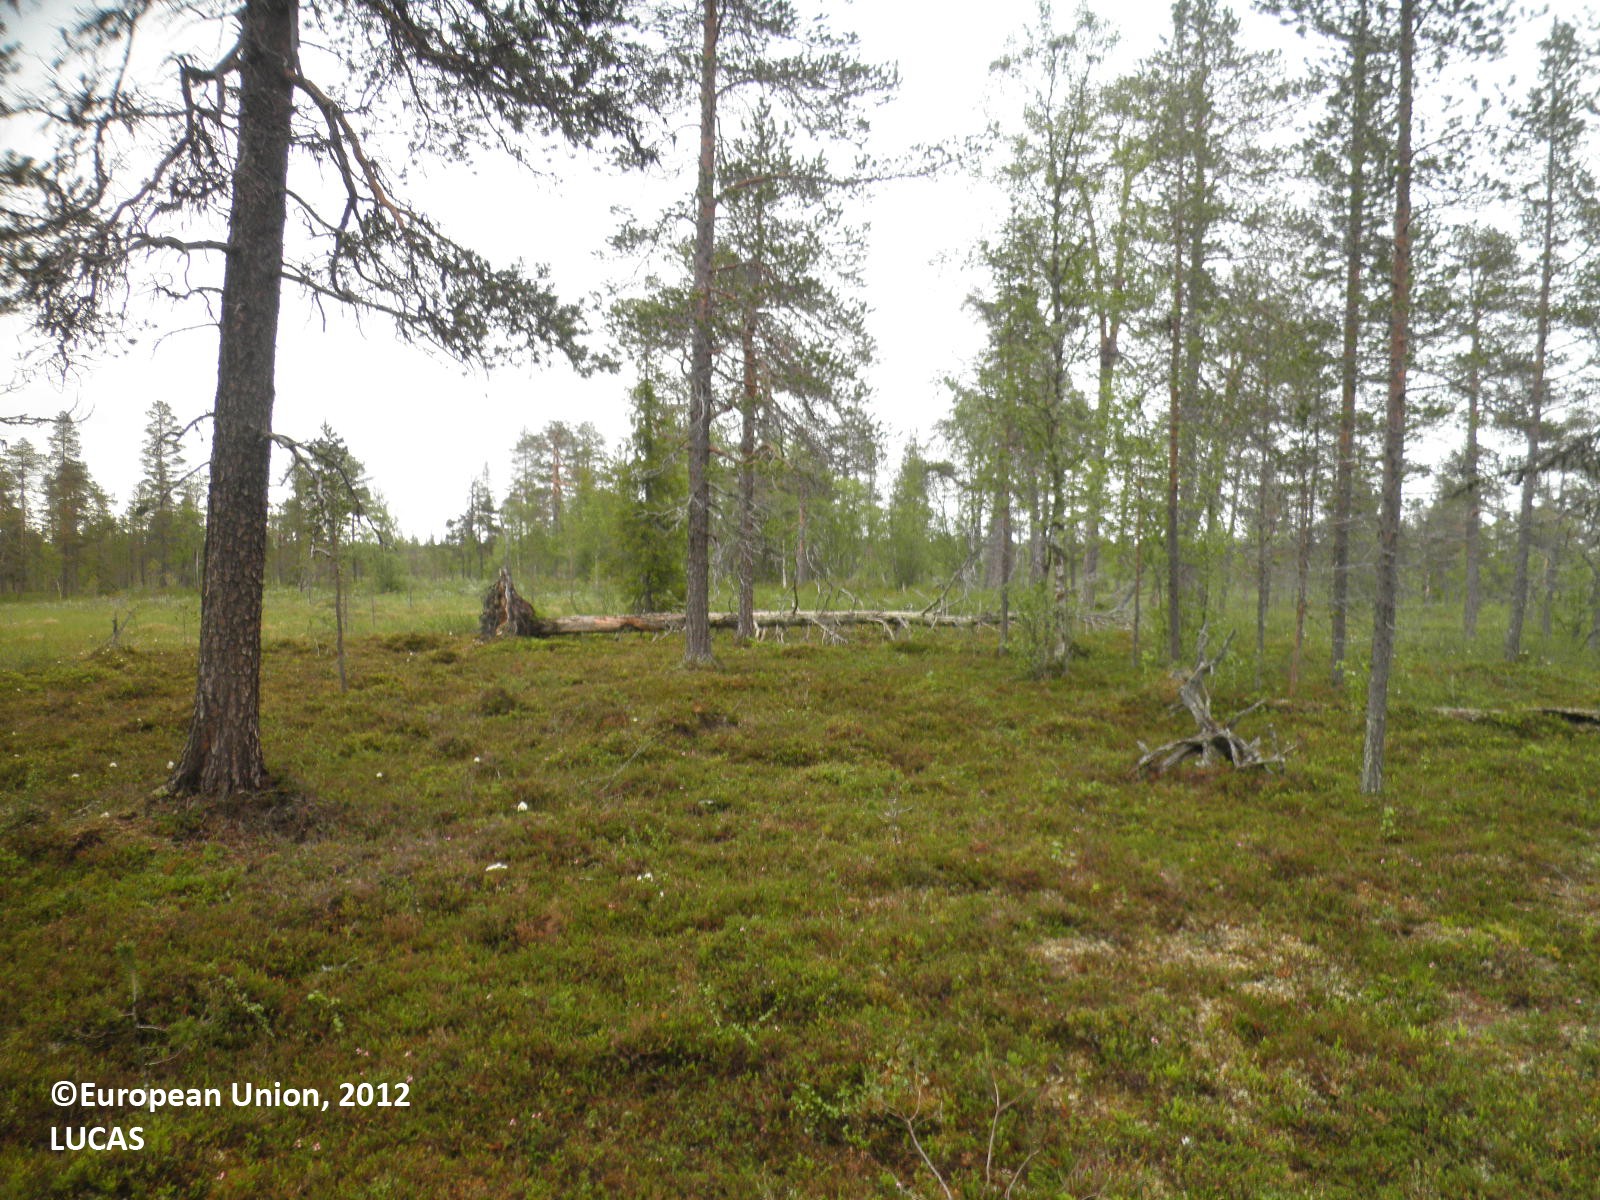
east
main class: Woodland
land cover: Pine dominated coniferous woodland
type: boreal forest
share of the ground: 50 - 75 %
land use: Forestry
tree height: > 5 m
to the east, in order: Pine dominated coniferous woodland; Pine dominated mixed woodland; Shrubland with sparse tree cover; Pine dominated mixed woodland; Shrubland with sparse tree cover; Ponds and wetlands; Shrubland with sparse tree cover; Ponds and wetlands; Shrubland with sparse tree cover; Inland water bodies; Shrubland without tree cover
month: July
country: FI
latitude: 68.2123
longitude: 25.6610
